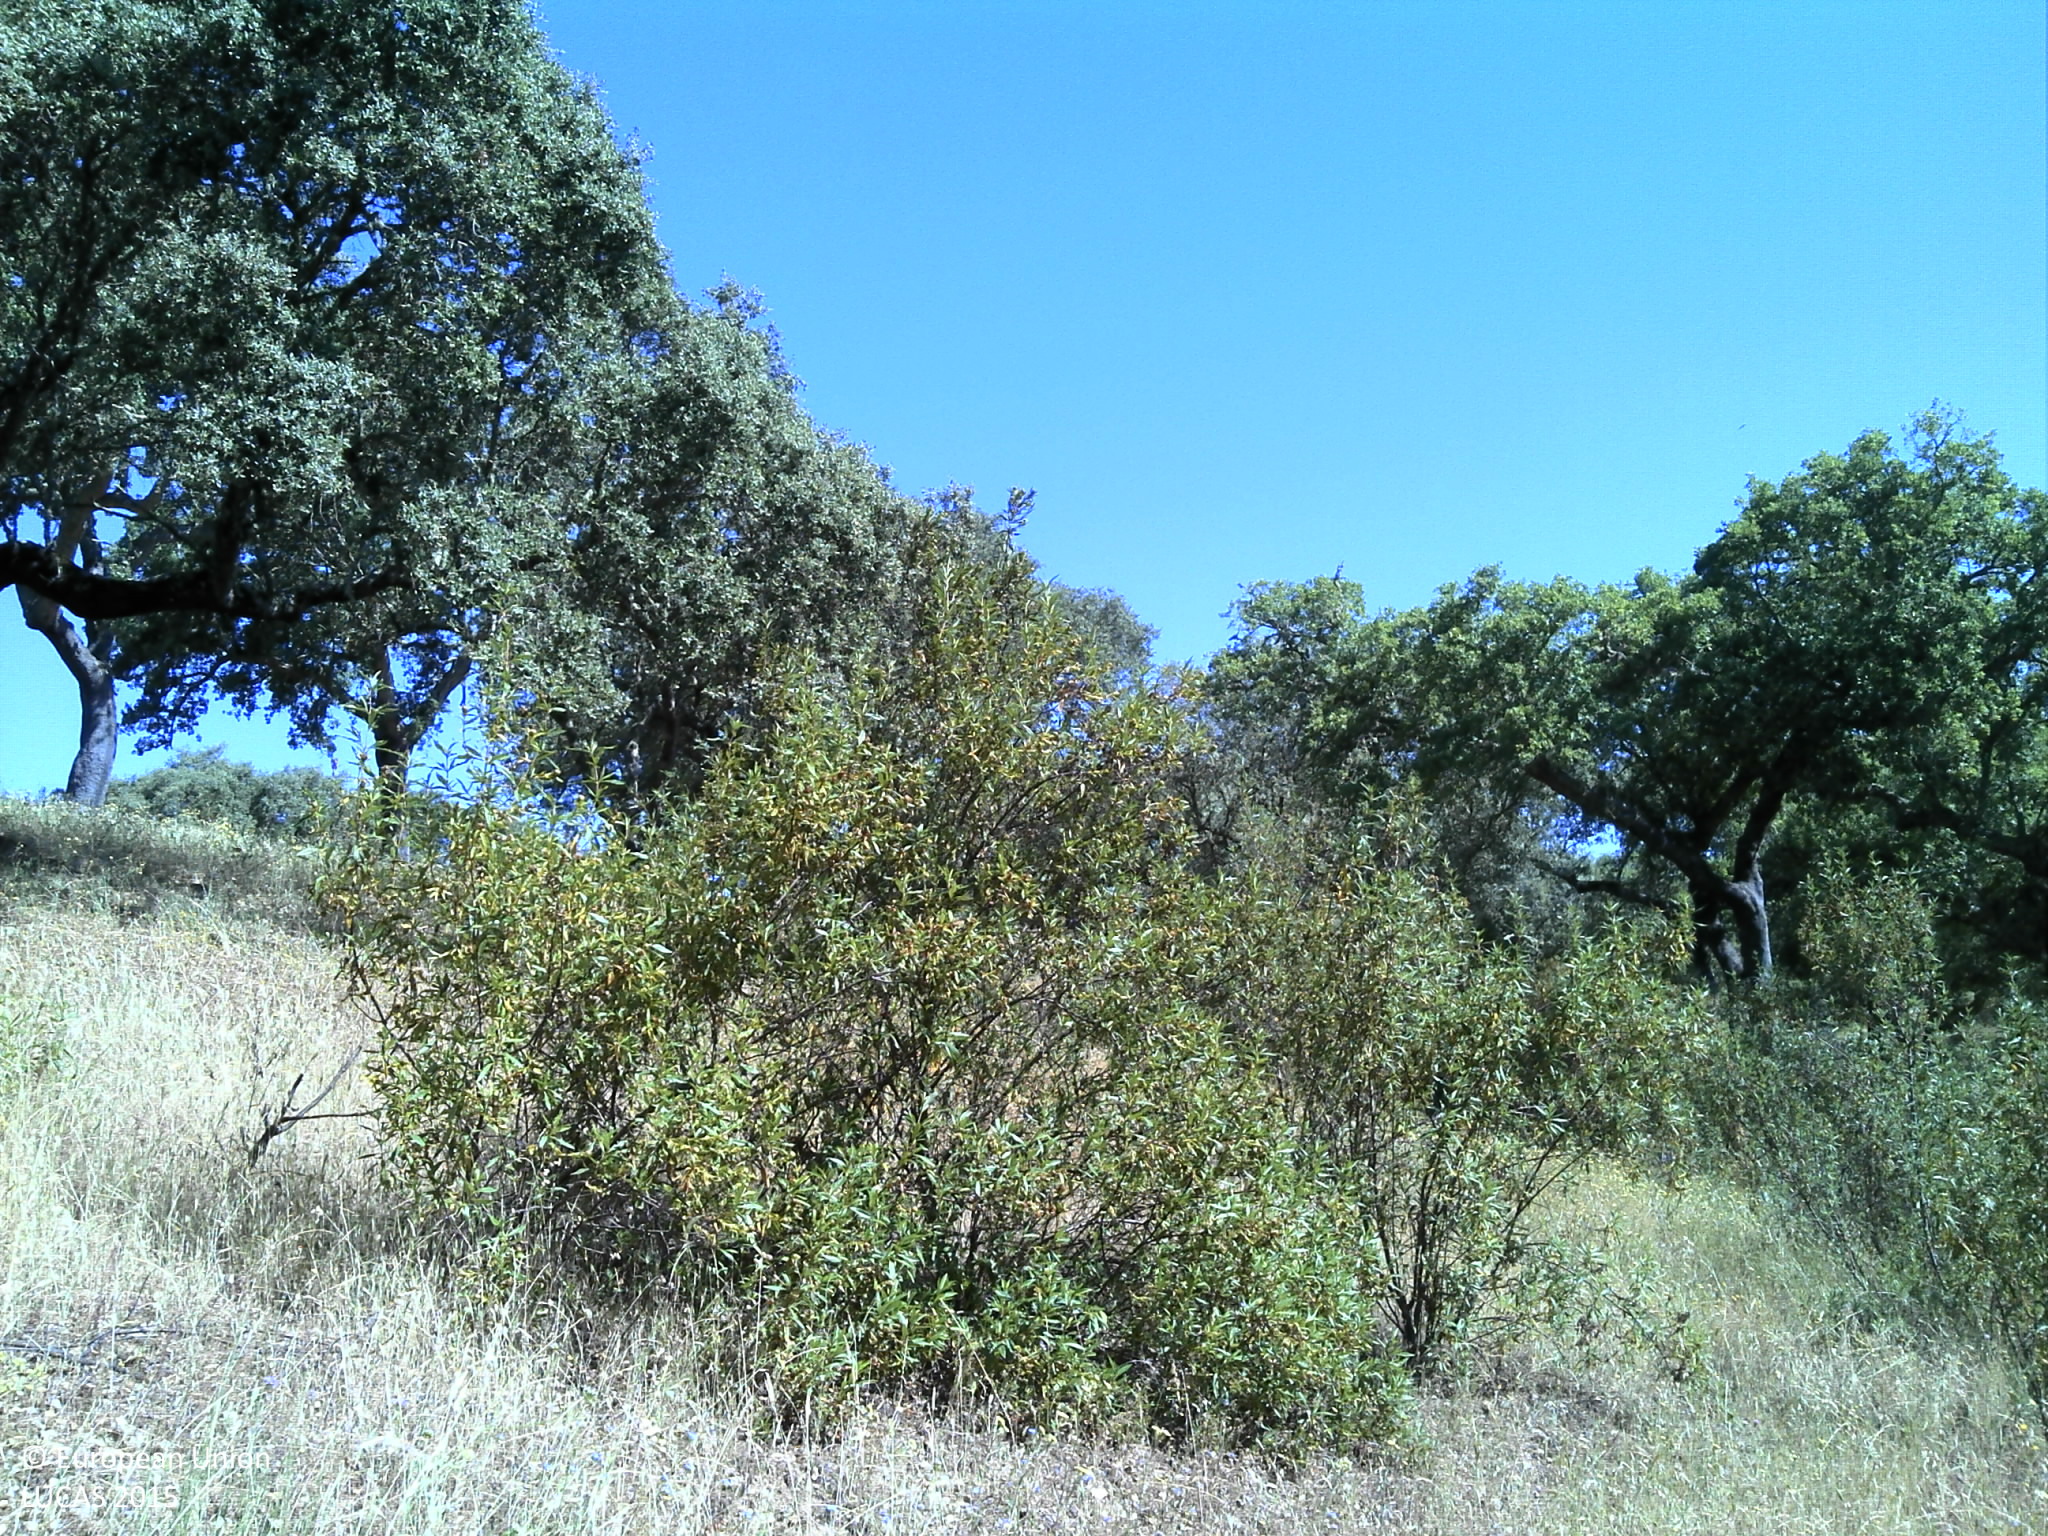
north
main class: Woodland
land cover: Broadleaved woodland
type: broadleaved evergreen forest
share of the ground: 25 - 50 %
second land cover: Shrubland without tree cover
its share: 25 - 50 %
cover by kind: broadleaved forest trees 40 %, herbaceous plants 25 %, unconsolidated bare surface 20 %, shrubs 15 %
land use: Forestry
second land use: Agriculture (excluding fallow land and kitchen gardens)
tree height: > 5 m
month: May
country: PT
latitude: 39.2201
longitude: -7.8766
